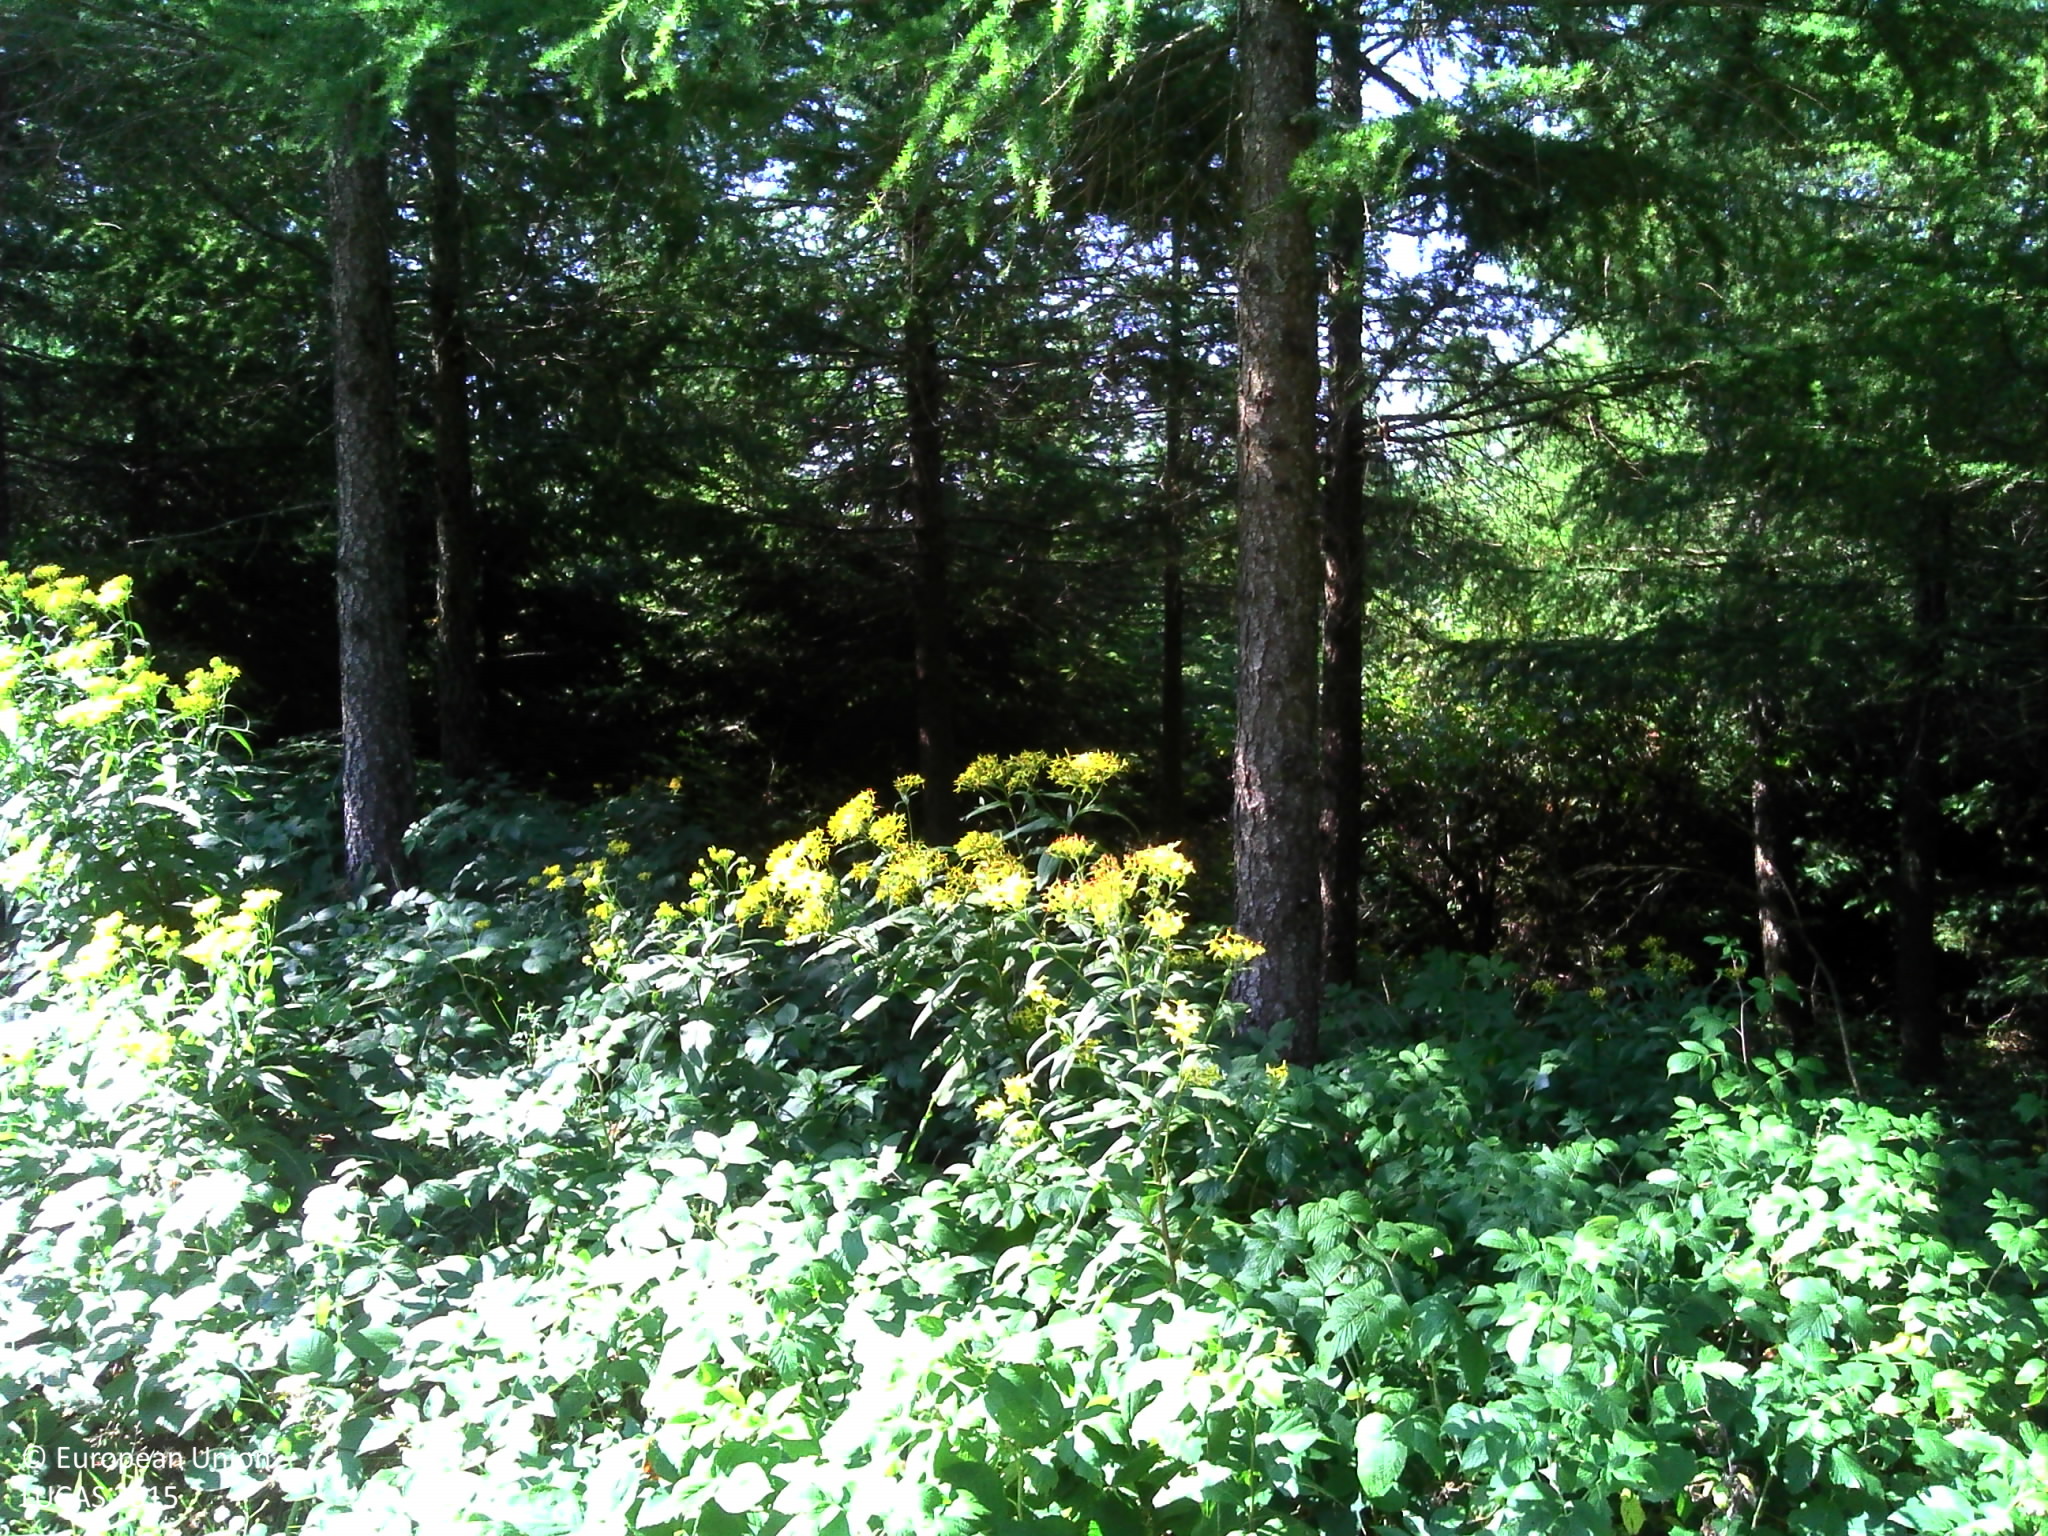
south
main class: Woodland
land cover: Other coniferous woodland
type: exotic forest
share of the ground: > 75 %
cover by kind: coniferous forest trees 65 %, herbaceous plants 25 %, shrubs 10 %
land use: Forestry
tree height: > 5 m
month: August
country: FR
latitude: 45.3651
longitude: 4.5782
